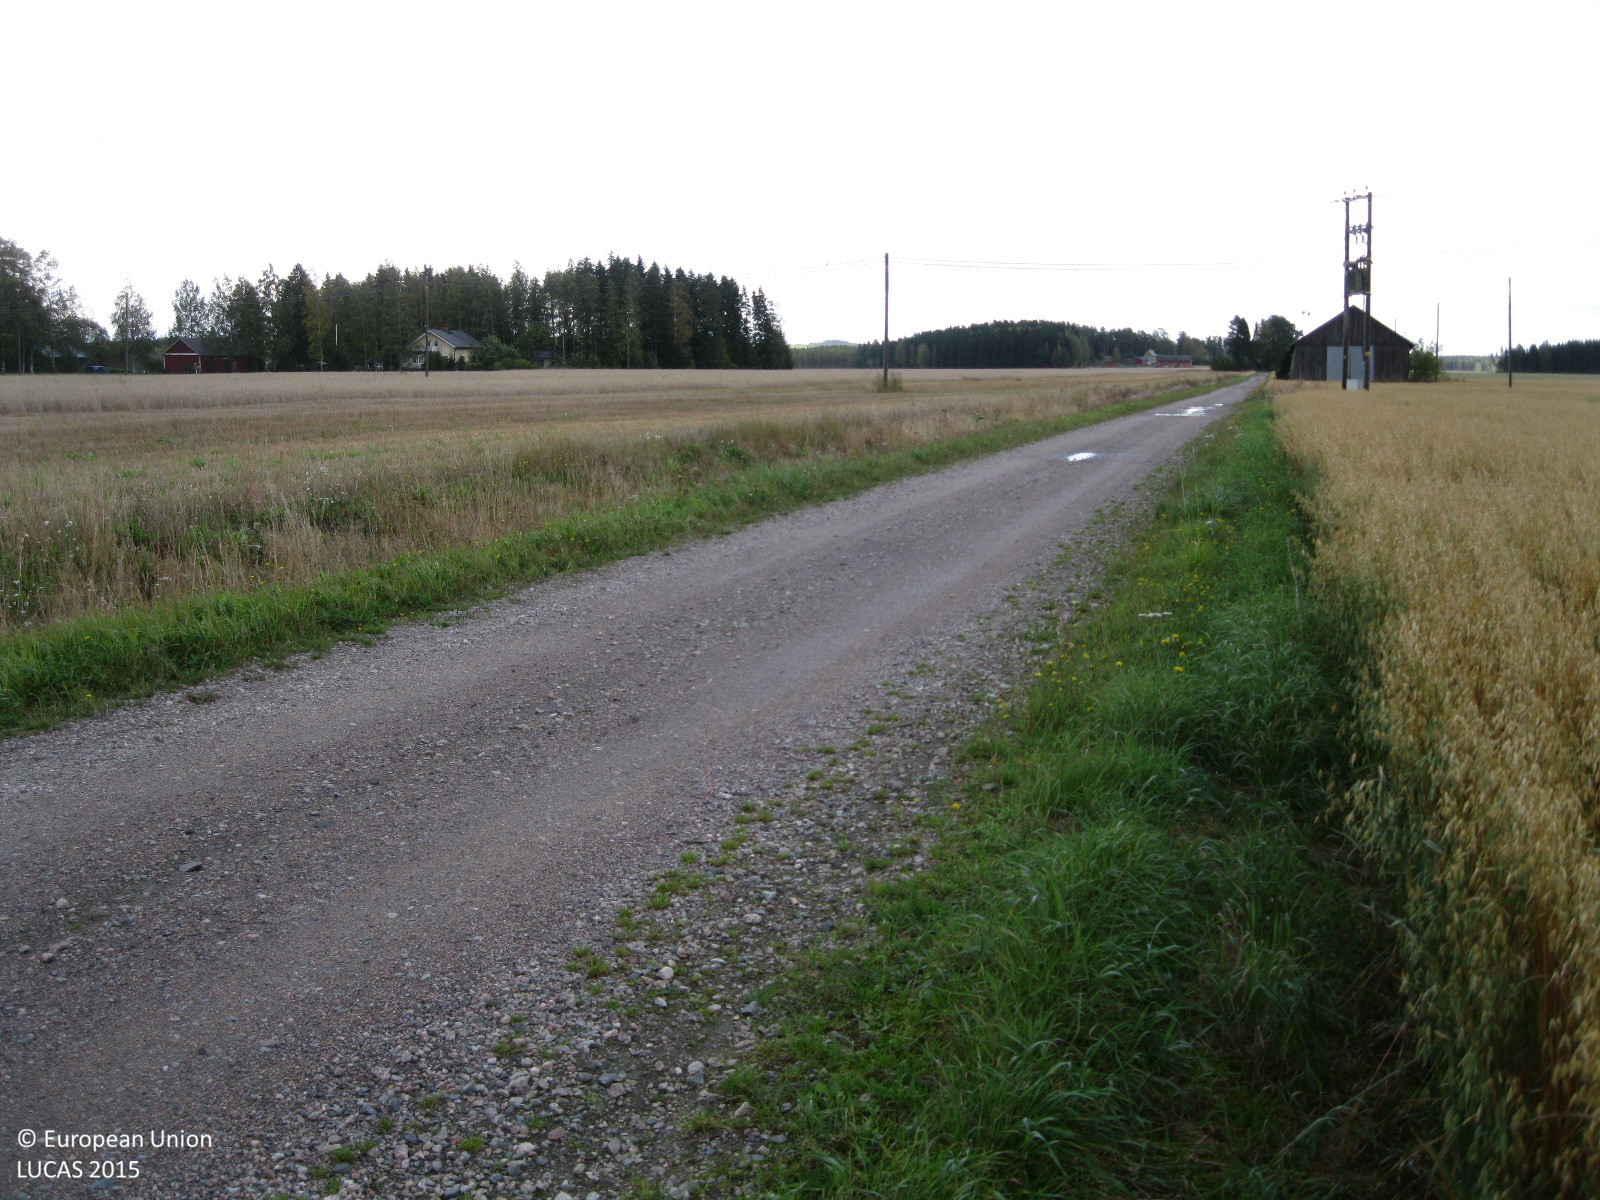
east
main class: Cropland
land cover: Oats
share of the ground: > 75 %
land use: Agriculture (excluding fallow land and kitchen gardens)
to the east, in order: Oats; Electric lines; Oats
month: September
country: FI
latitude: 60.8862
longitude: 24.7569
